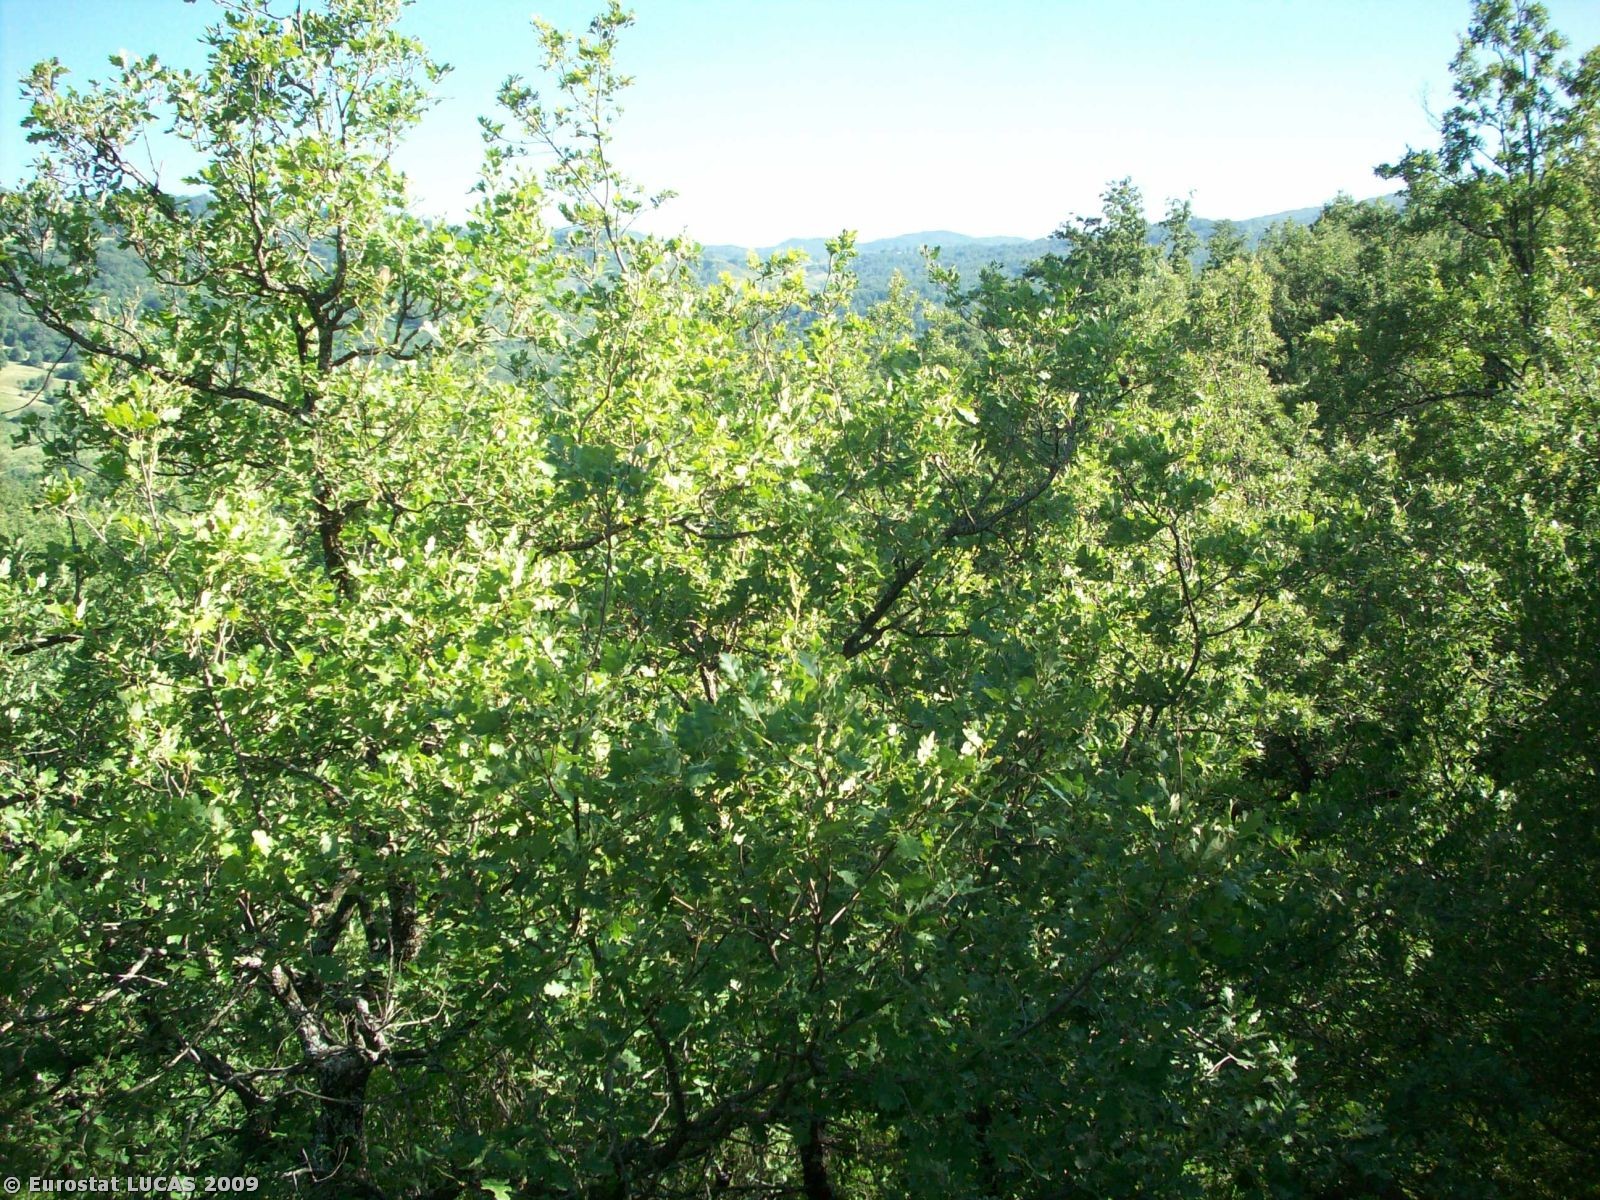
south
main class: Woodland
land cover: Broadleaved woodland
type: broadleaved evergreen forest
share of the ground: > 75 %
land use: Nature reserves
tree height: > 5 m
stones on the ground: 10 - 25 %
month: June
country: IT
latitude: 40.0501
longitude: 16.2450
